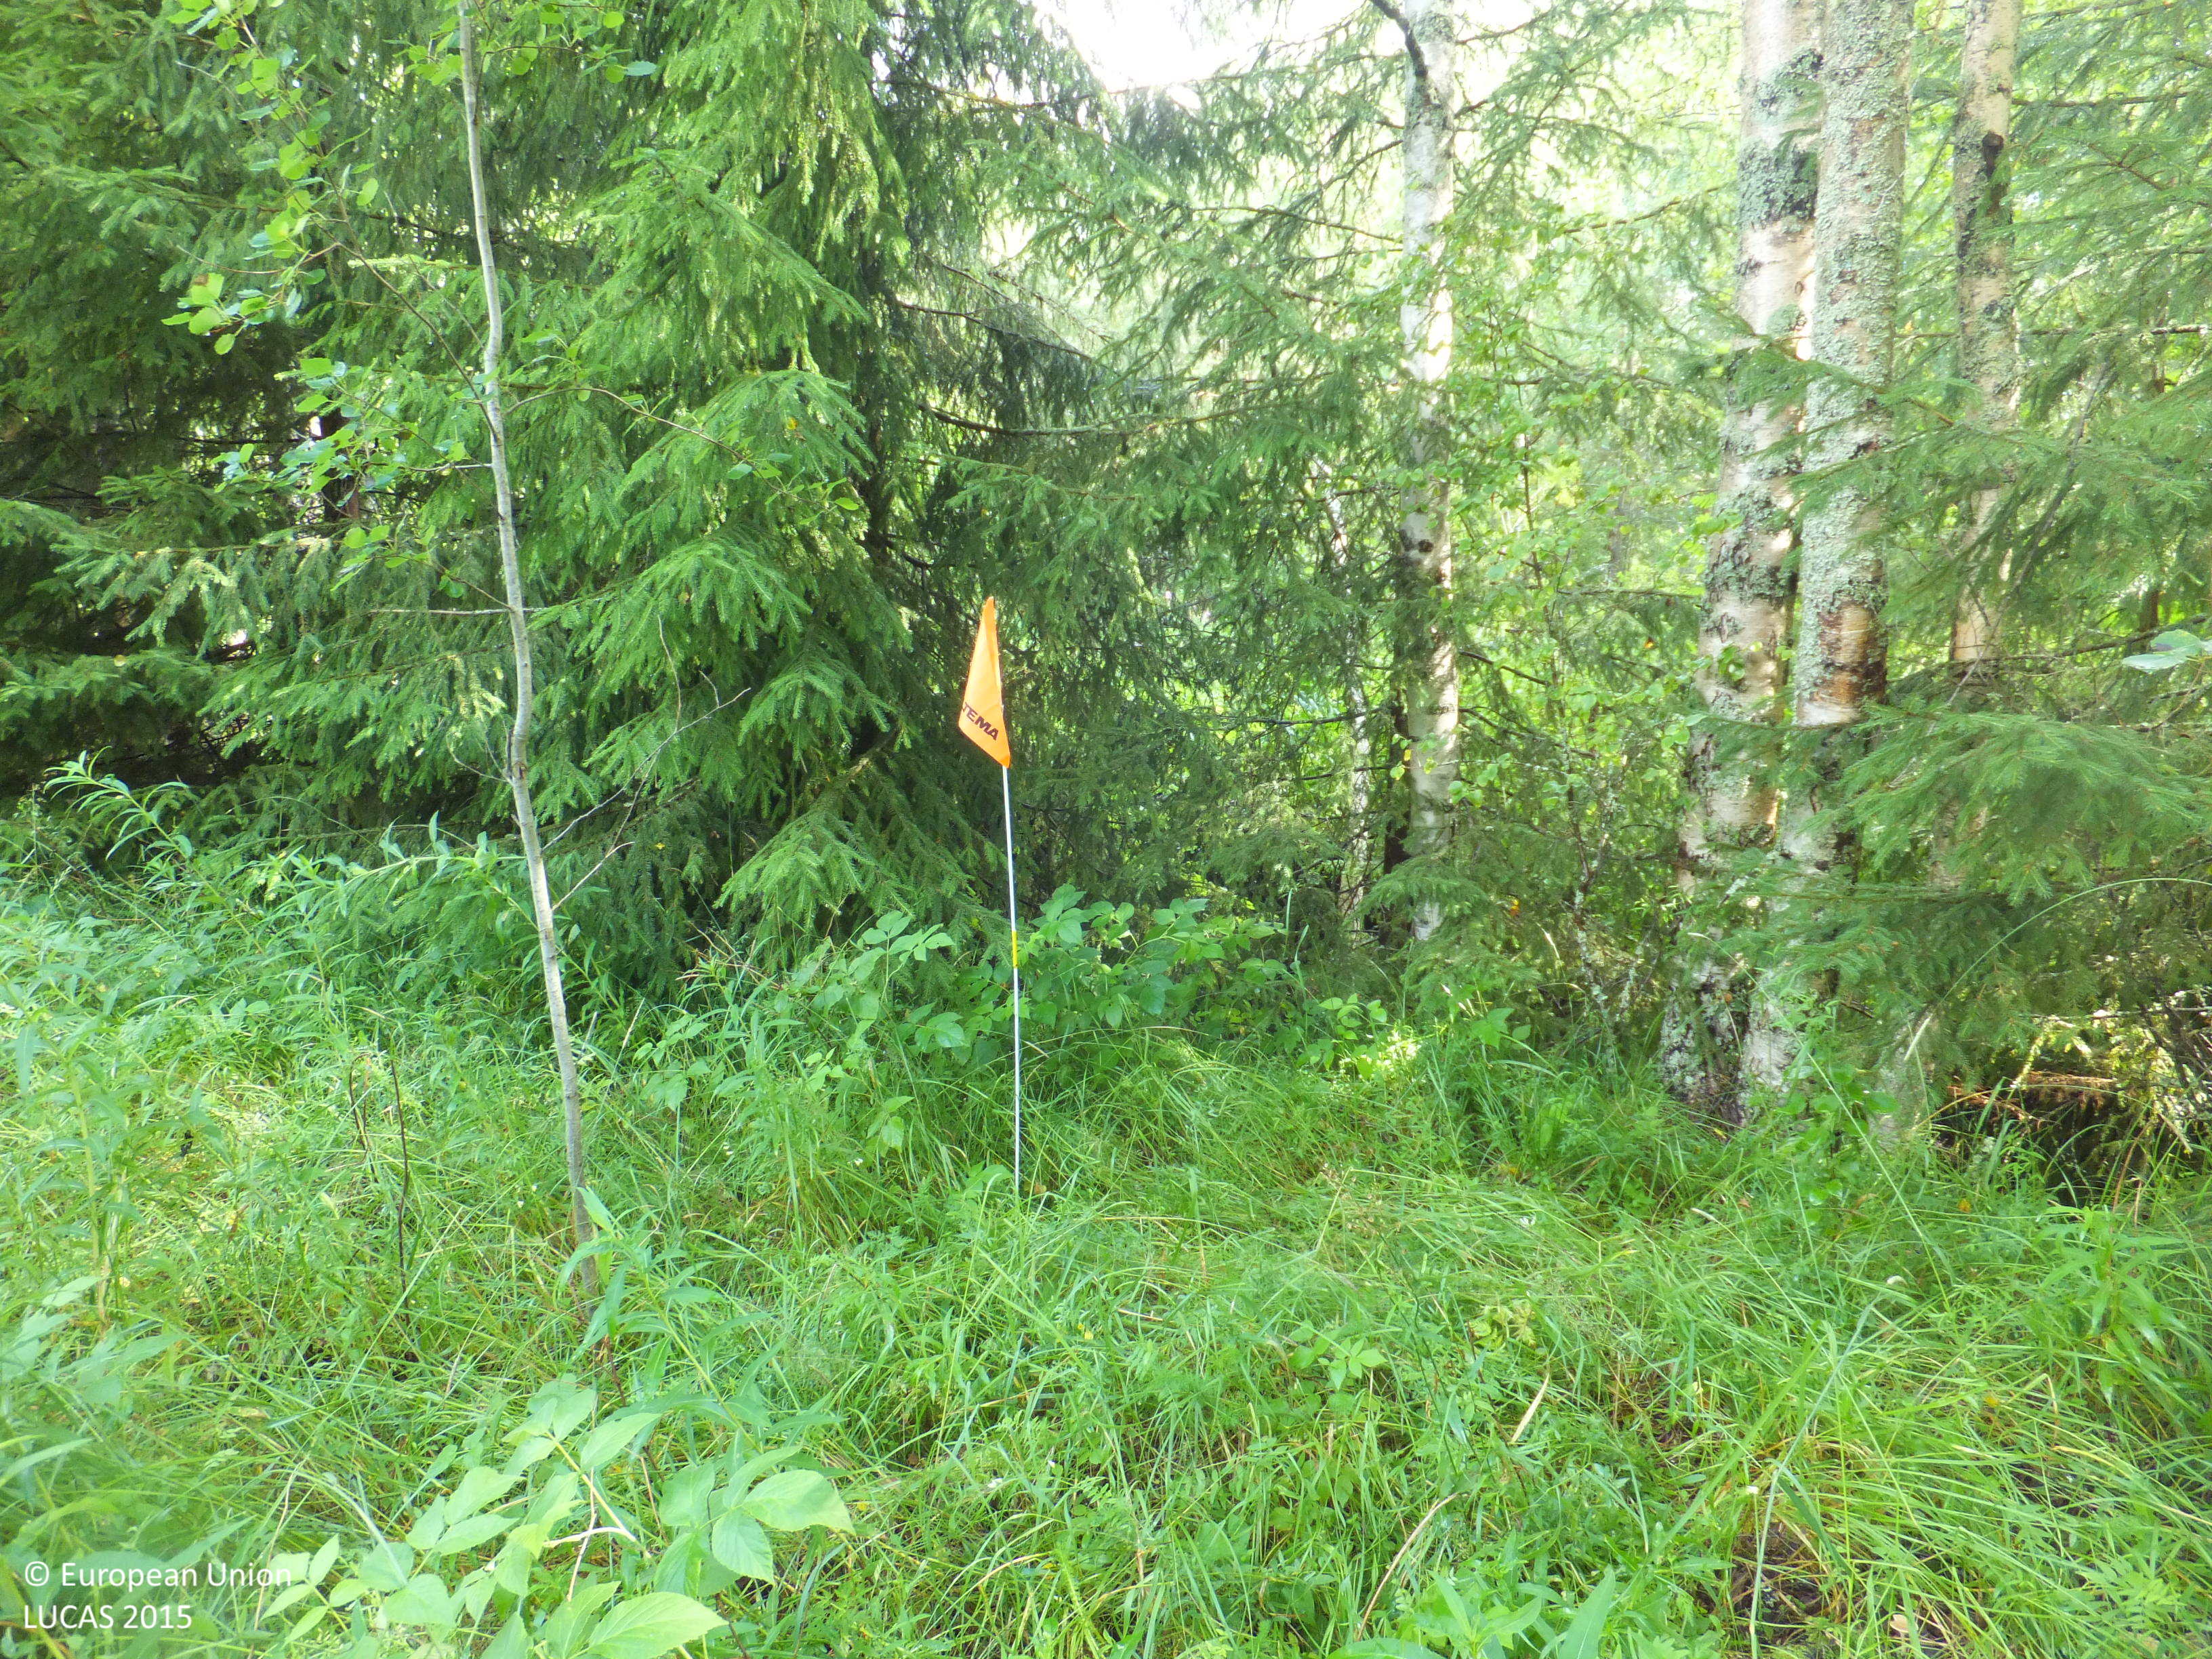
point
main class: Woodland
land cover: Spruce dominated mixed woodland
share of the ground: 50 - 75 %
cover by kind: herbaceous plants 40 %, broadleaved forest trees 30 %, coniferous forest trees 20 %, shrubs 10 %
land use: Semi-natural and natural areas not in use
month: July
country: FI
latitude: 63.1919
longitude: 21.9879
